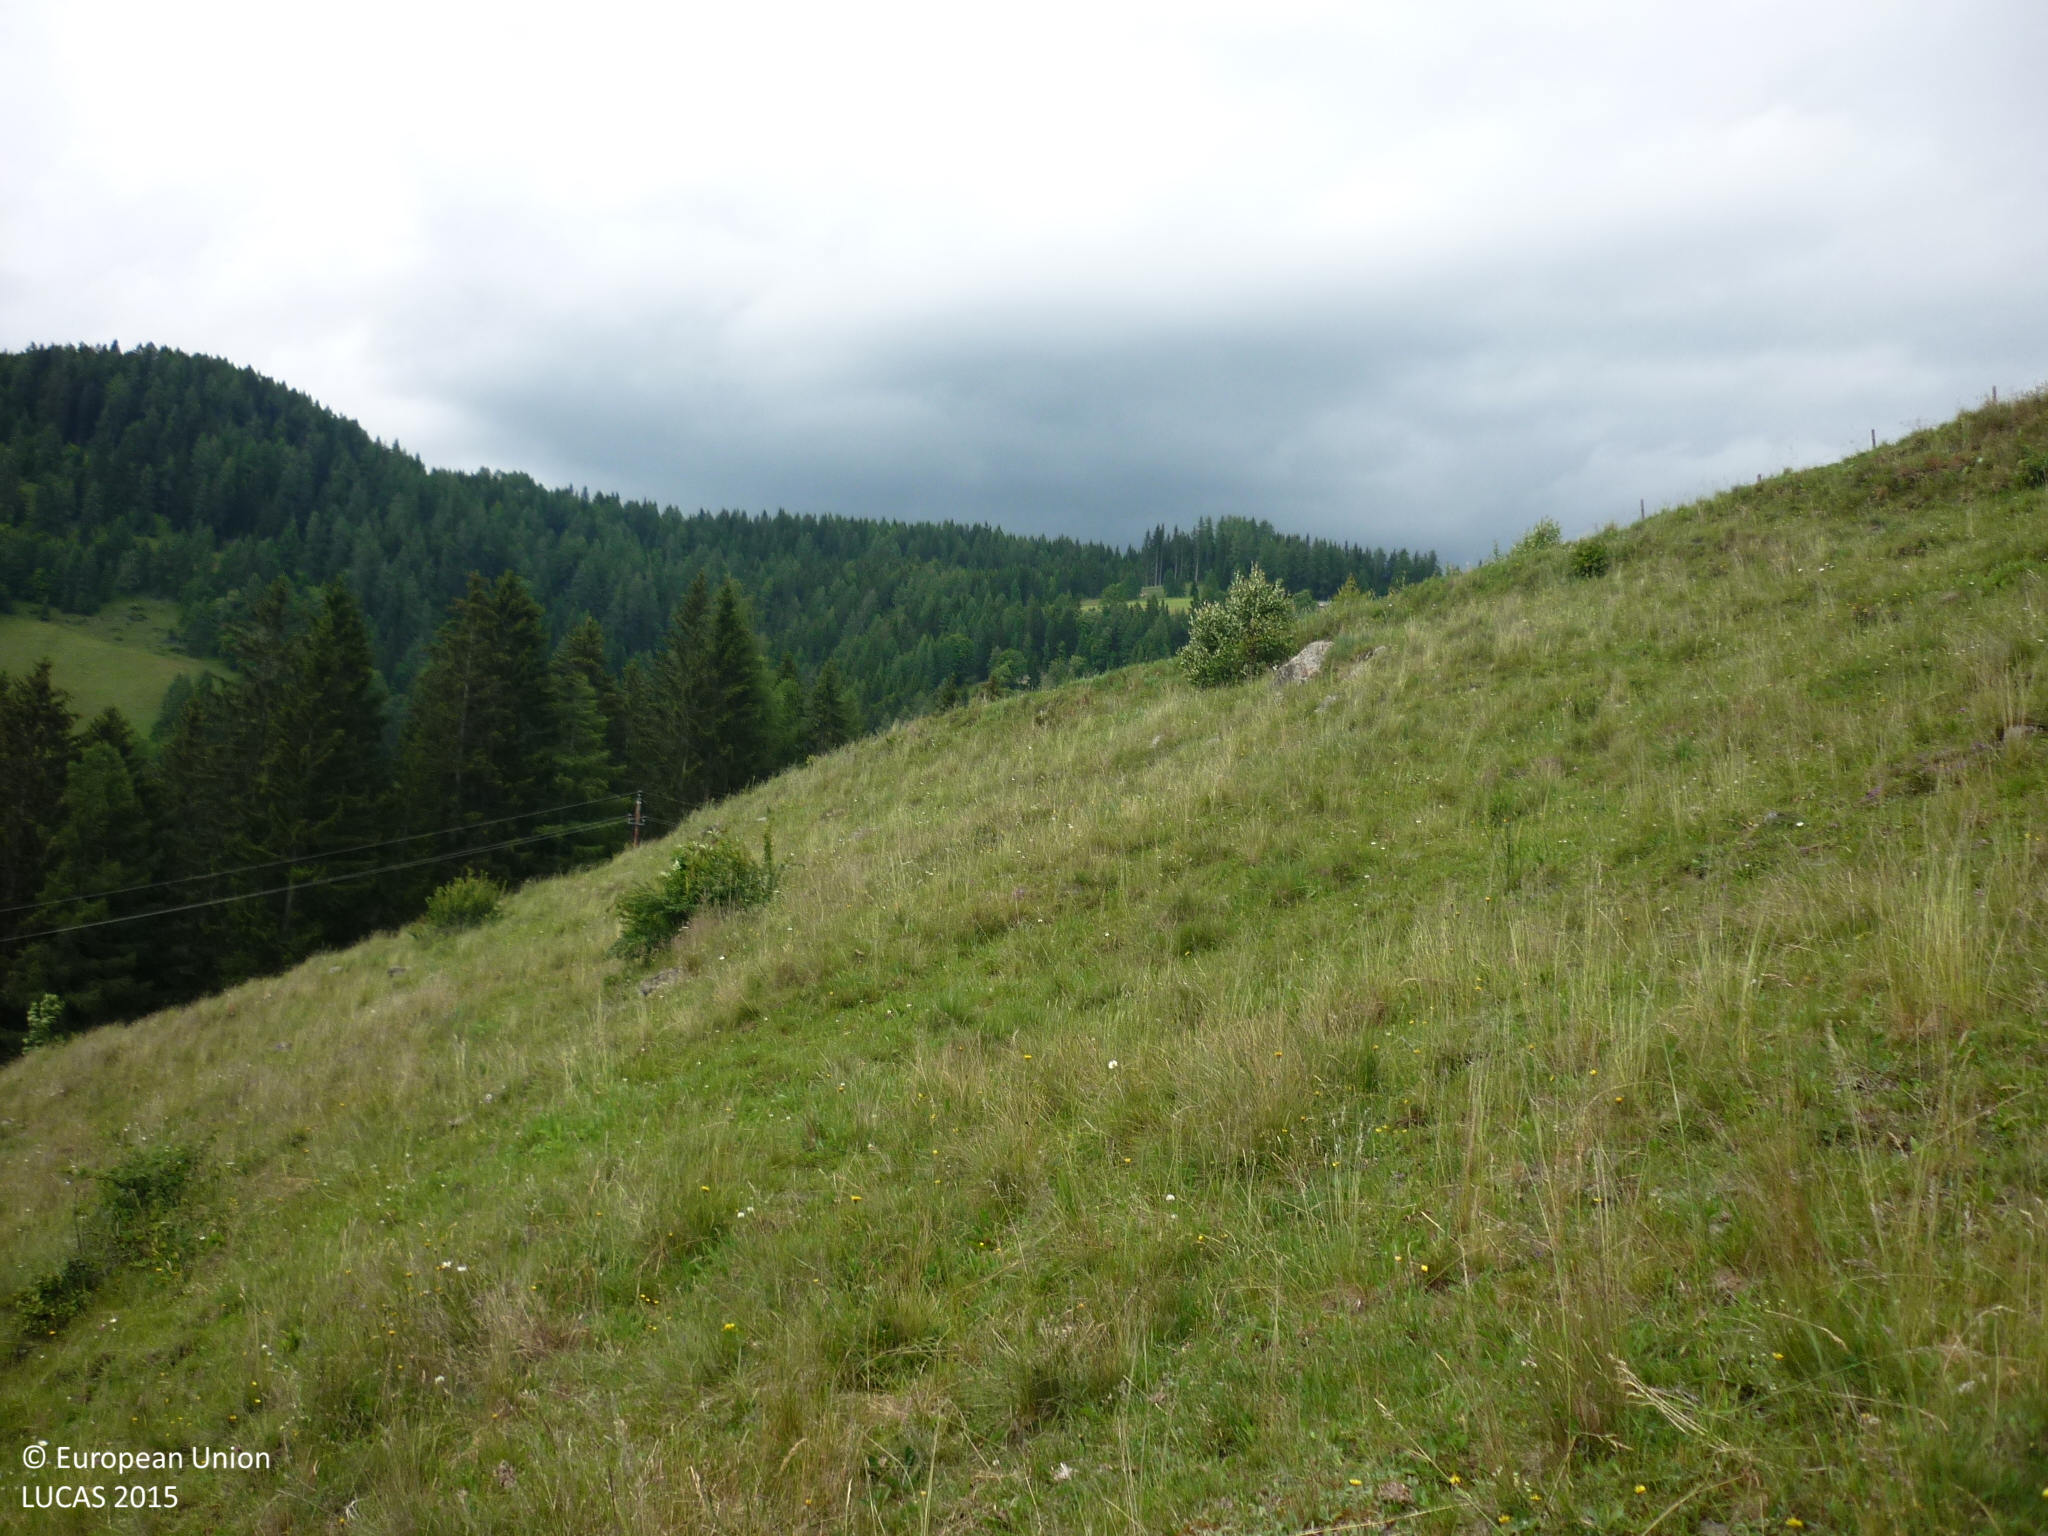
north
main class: Grassland
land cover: Grassland with sparse tree/shrub cover
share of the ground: > 75 %
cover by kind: herbaceous plants 85 %, broadleaved forest trees 5 %, shrubs 5 %, consolidated bare surface 5 %
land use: Agriculture (excluding fallow land and kitchen gardens)
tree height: < 5 m
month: June
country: AT
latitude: 47.2019
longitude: 14.3151
